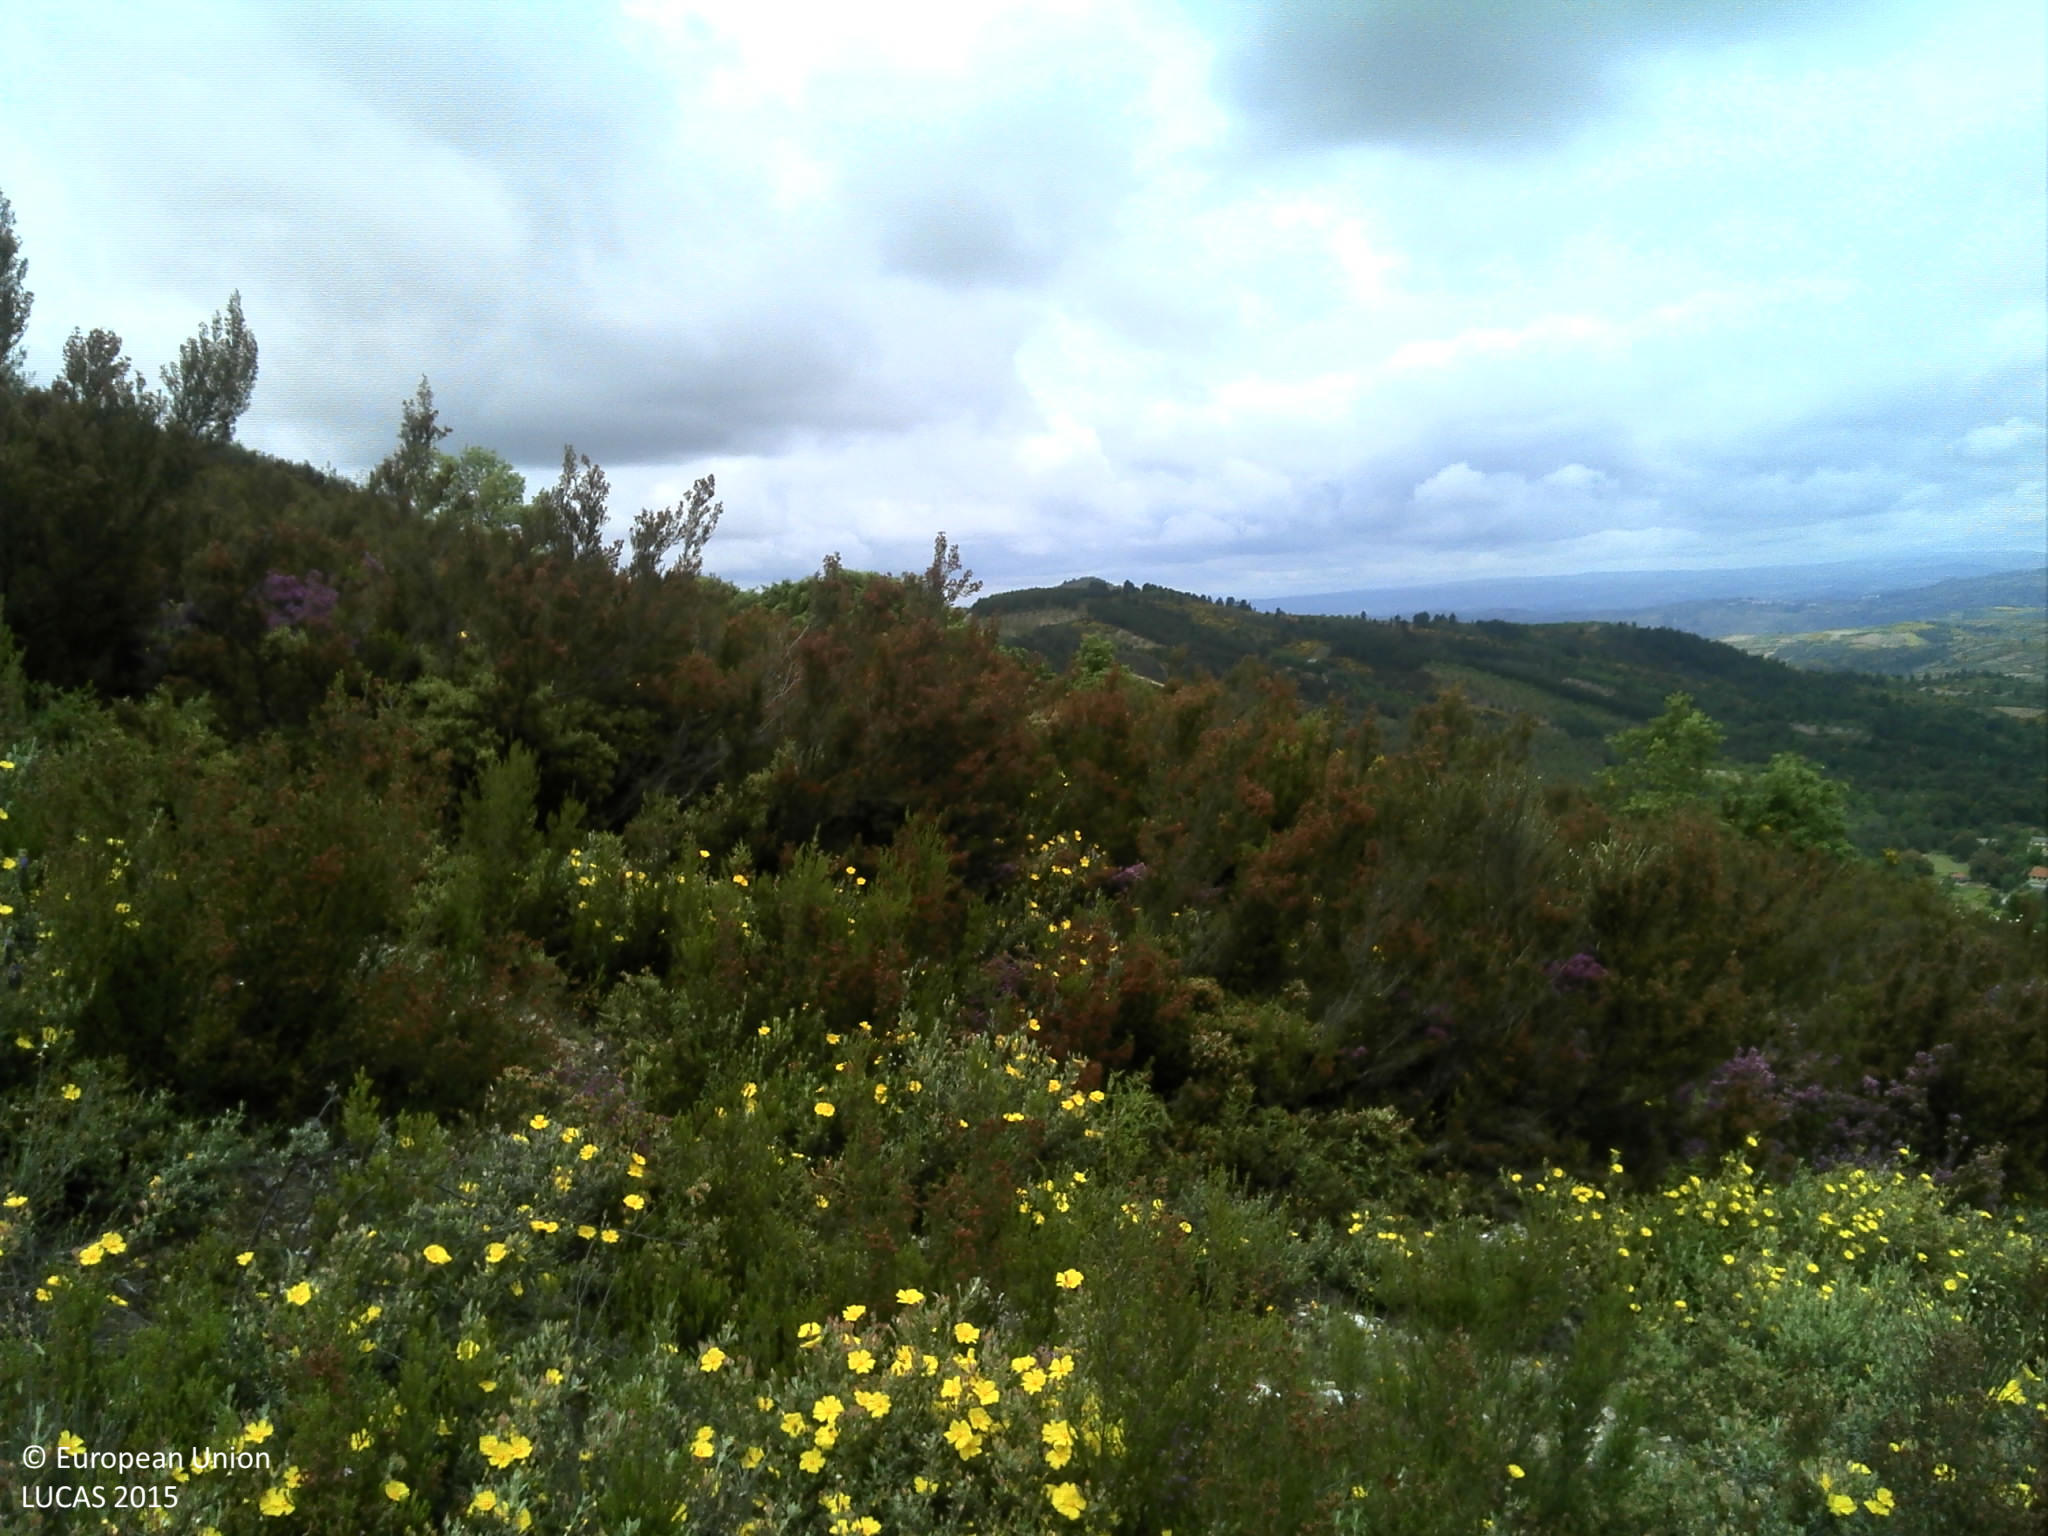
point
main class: Shrubland
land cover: Shrubland with sparse tree cover
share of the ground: > 75 %
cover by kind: shrubs 90 %, broadleaved forest trees 5 %, unconsolidated bare surface 5 %
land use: Abandoned areas
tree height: > 5 m
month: May
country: PT
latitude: 41.6178
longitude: -6.9529
